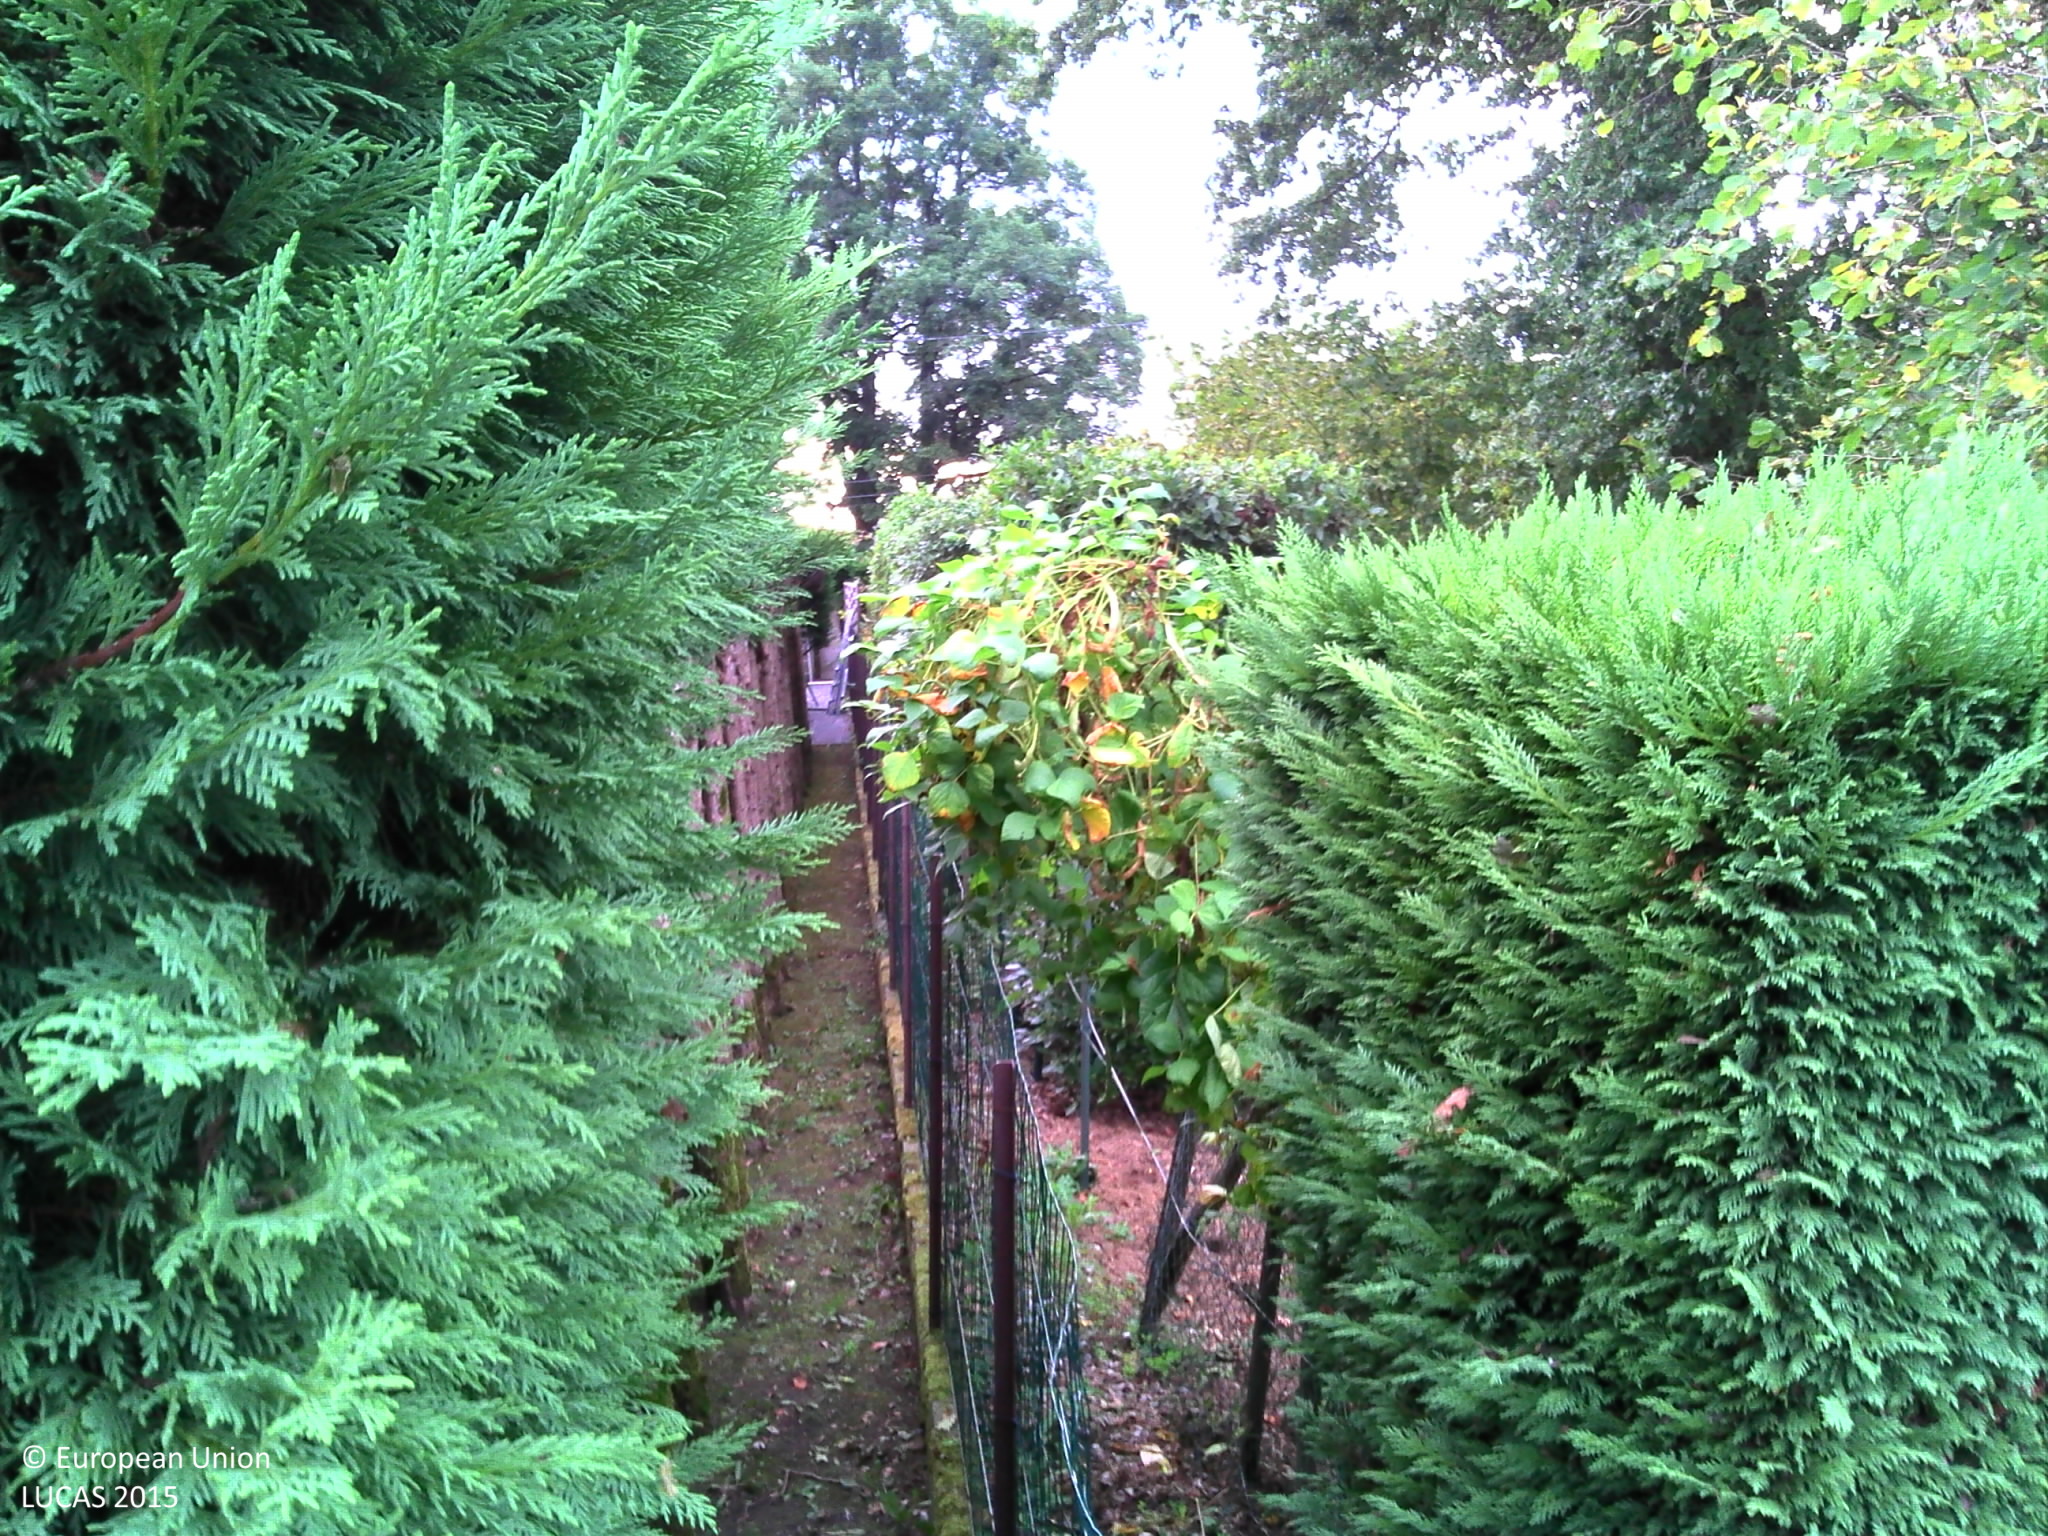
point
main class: Woodland
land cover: Broadleaved woodland
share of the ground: > 75 %
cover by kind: broadleaved forest trees 80 %, herbaceous plants 20 %
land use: Residential
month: September
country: FR
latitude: 43.3914
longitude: -0.3900
